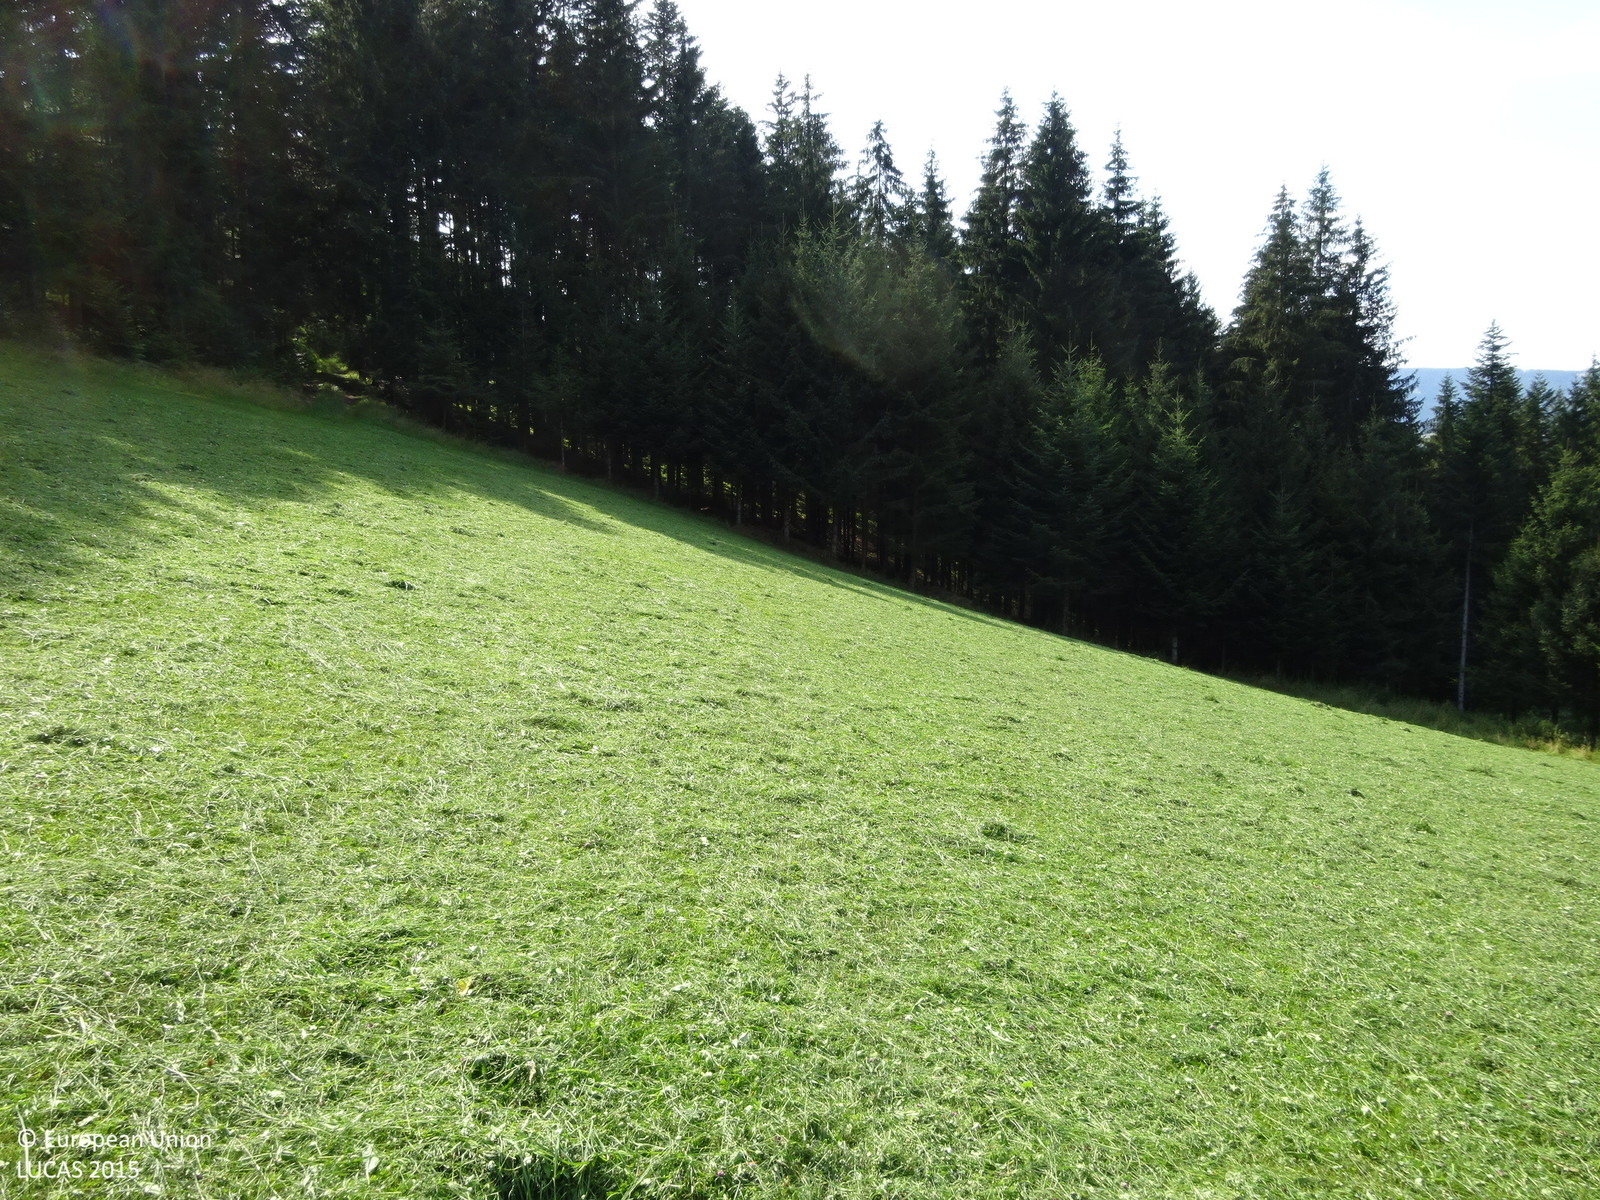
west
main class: Grassland
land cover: Grassland without tree/shrub cover
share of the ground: > 75 %
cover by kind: herbaceous plants 100 %
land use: Agriculture (excluding fallow land and kitchen gardens)
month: August
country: AT
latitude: 47.4438
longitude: 15.7168
